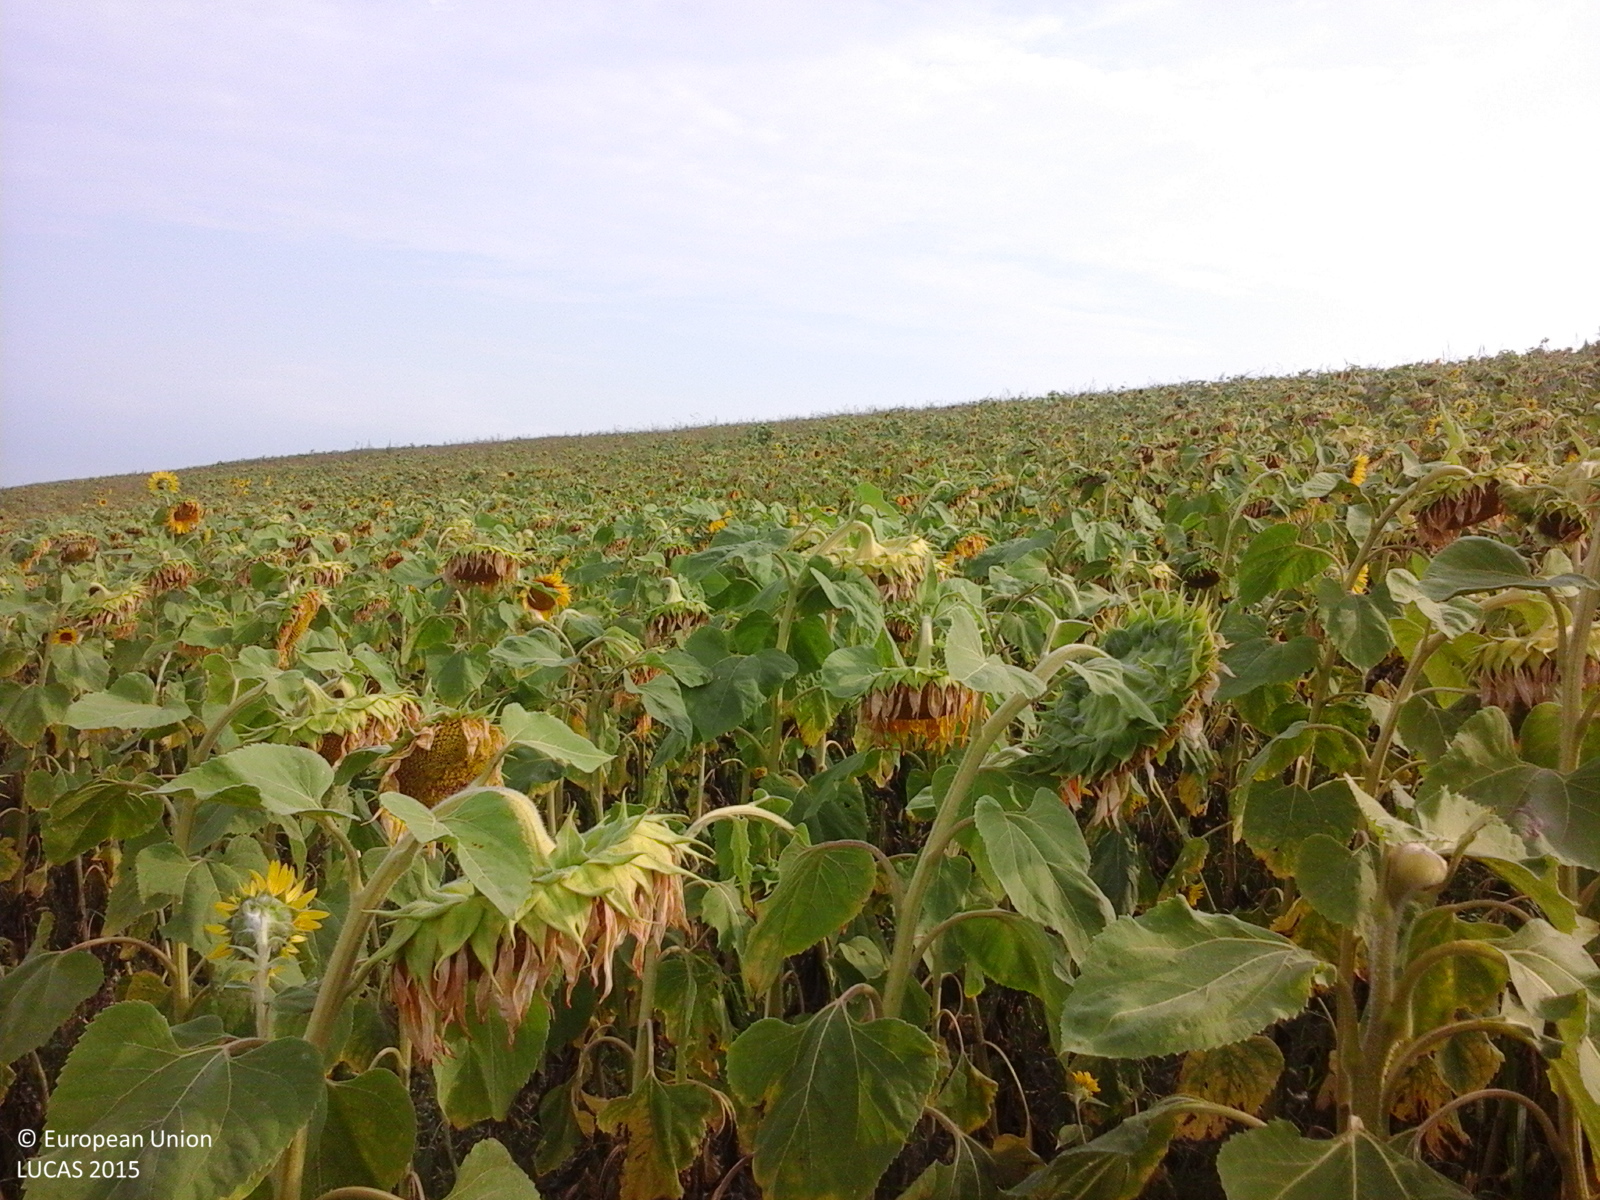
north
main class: Cropland
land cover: Sunflower
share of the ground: > 75 %
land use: Agriculture (excluding fallow land and kitchen gardens)
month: August
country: RO
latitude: 45.1143
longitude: 28.8660
